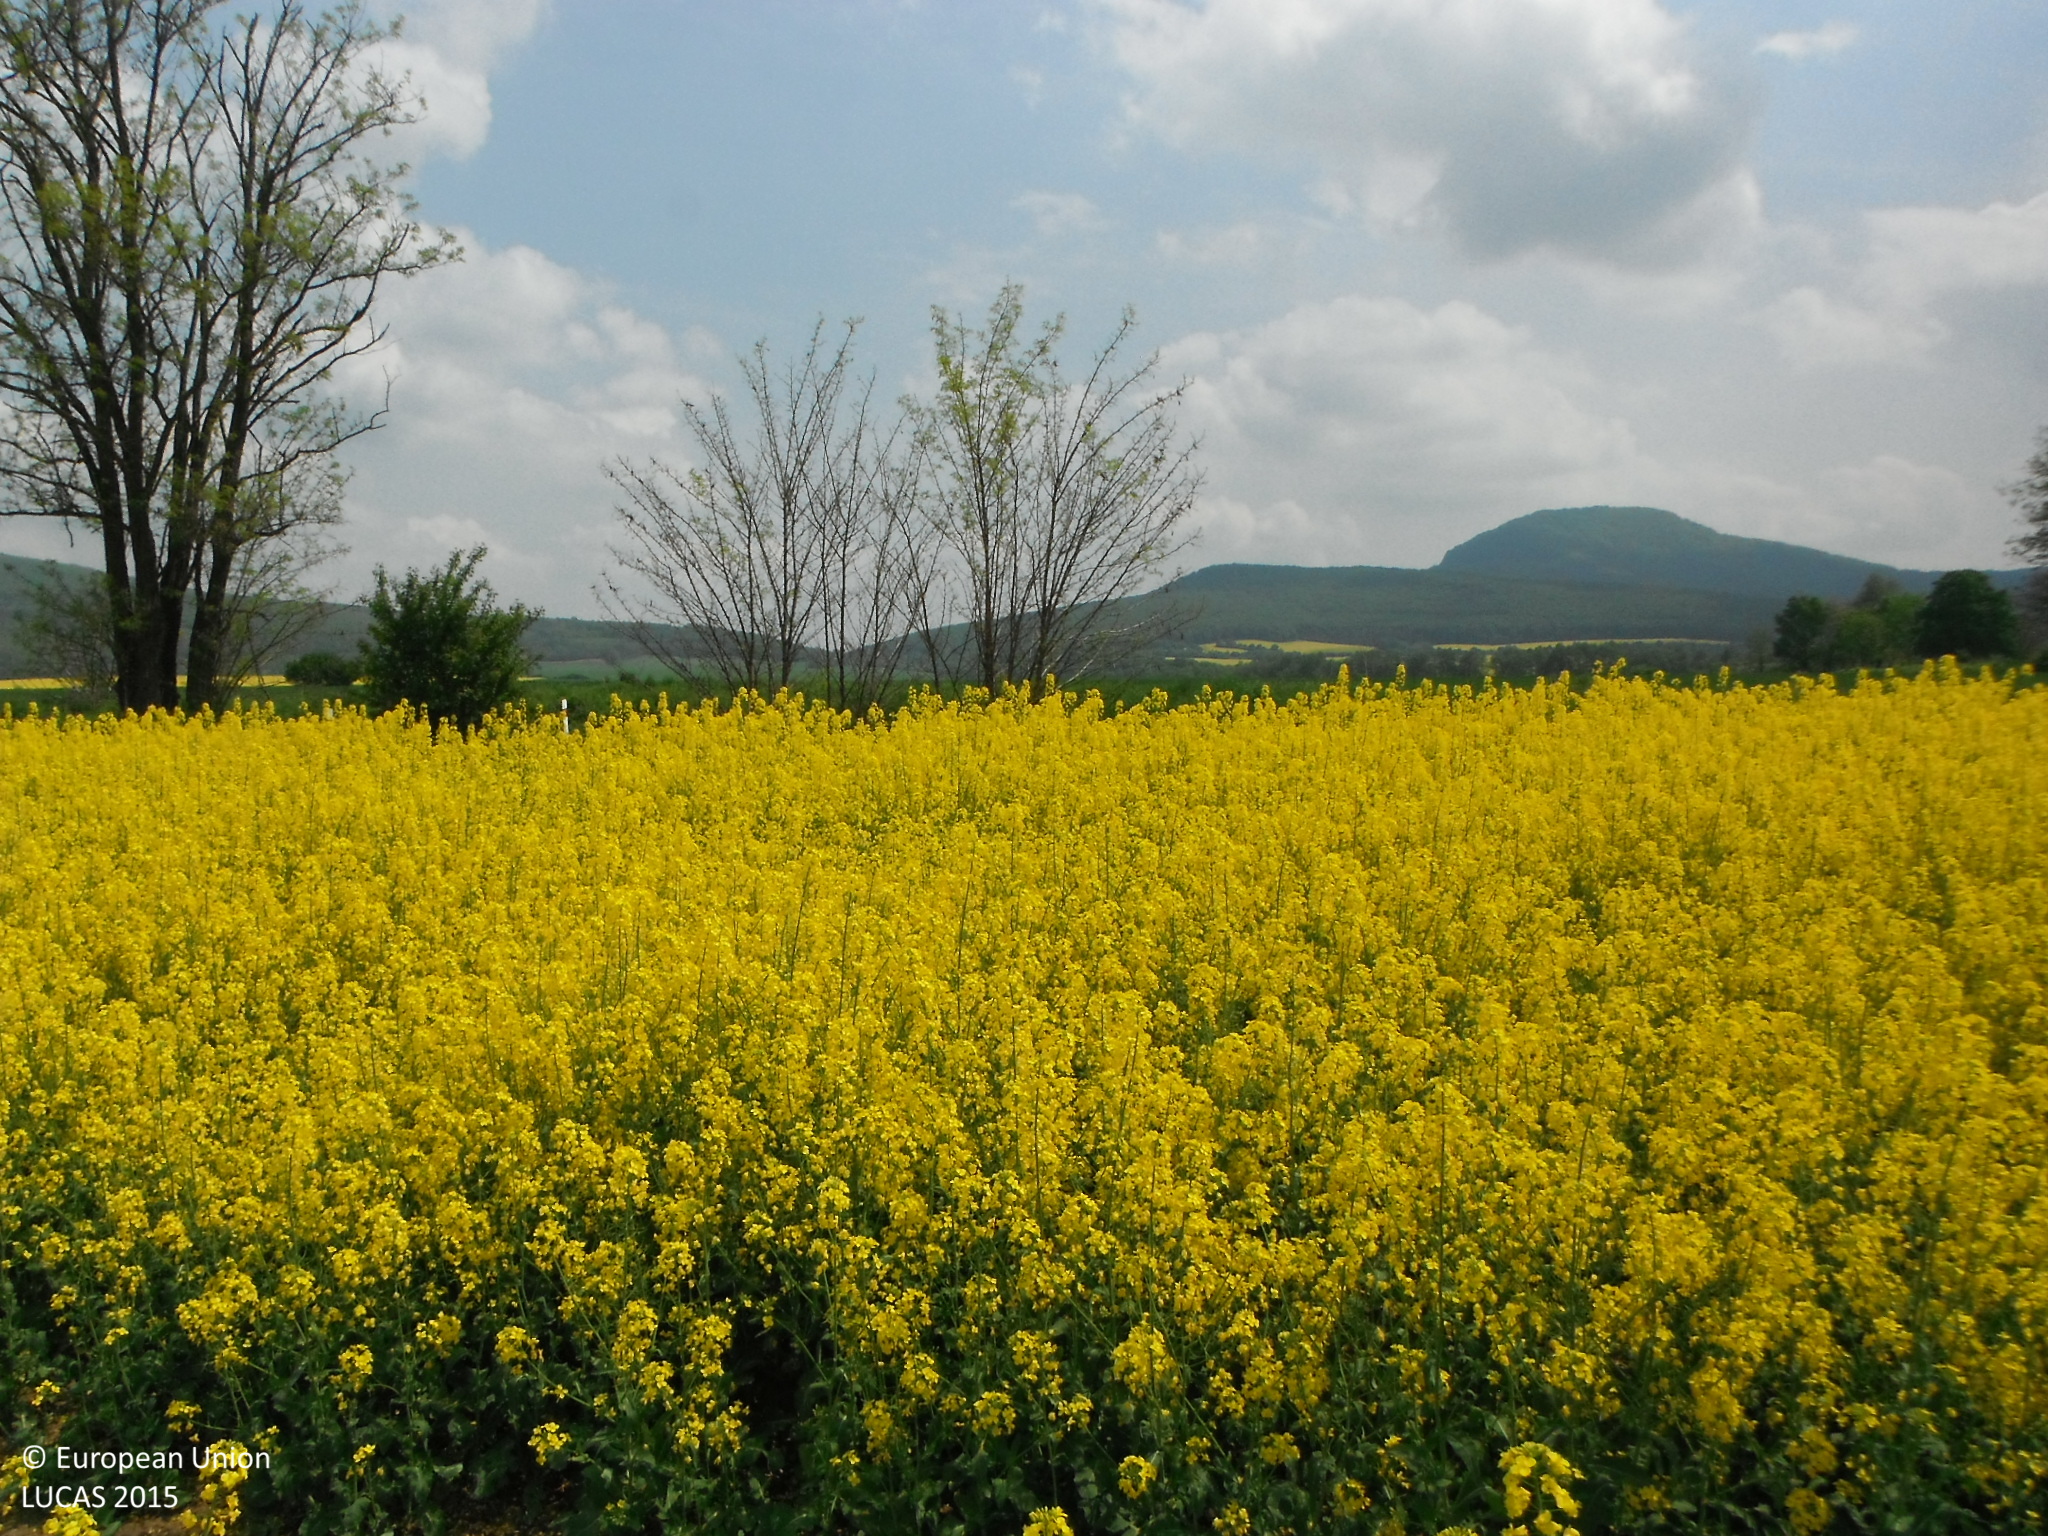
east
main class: Cropland
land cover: Rape and turnip rape
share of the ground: > 75 %
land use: Agriculture (excluding fallow land and kitchen gardens)
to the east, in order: Rape and turnip rape
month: May
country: SK
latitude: 48.3950
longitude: 18.1039
